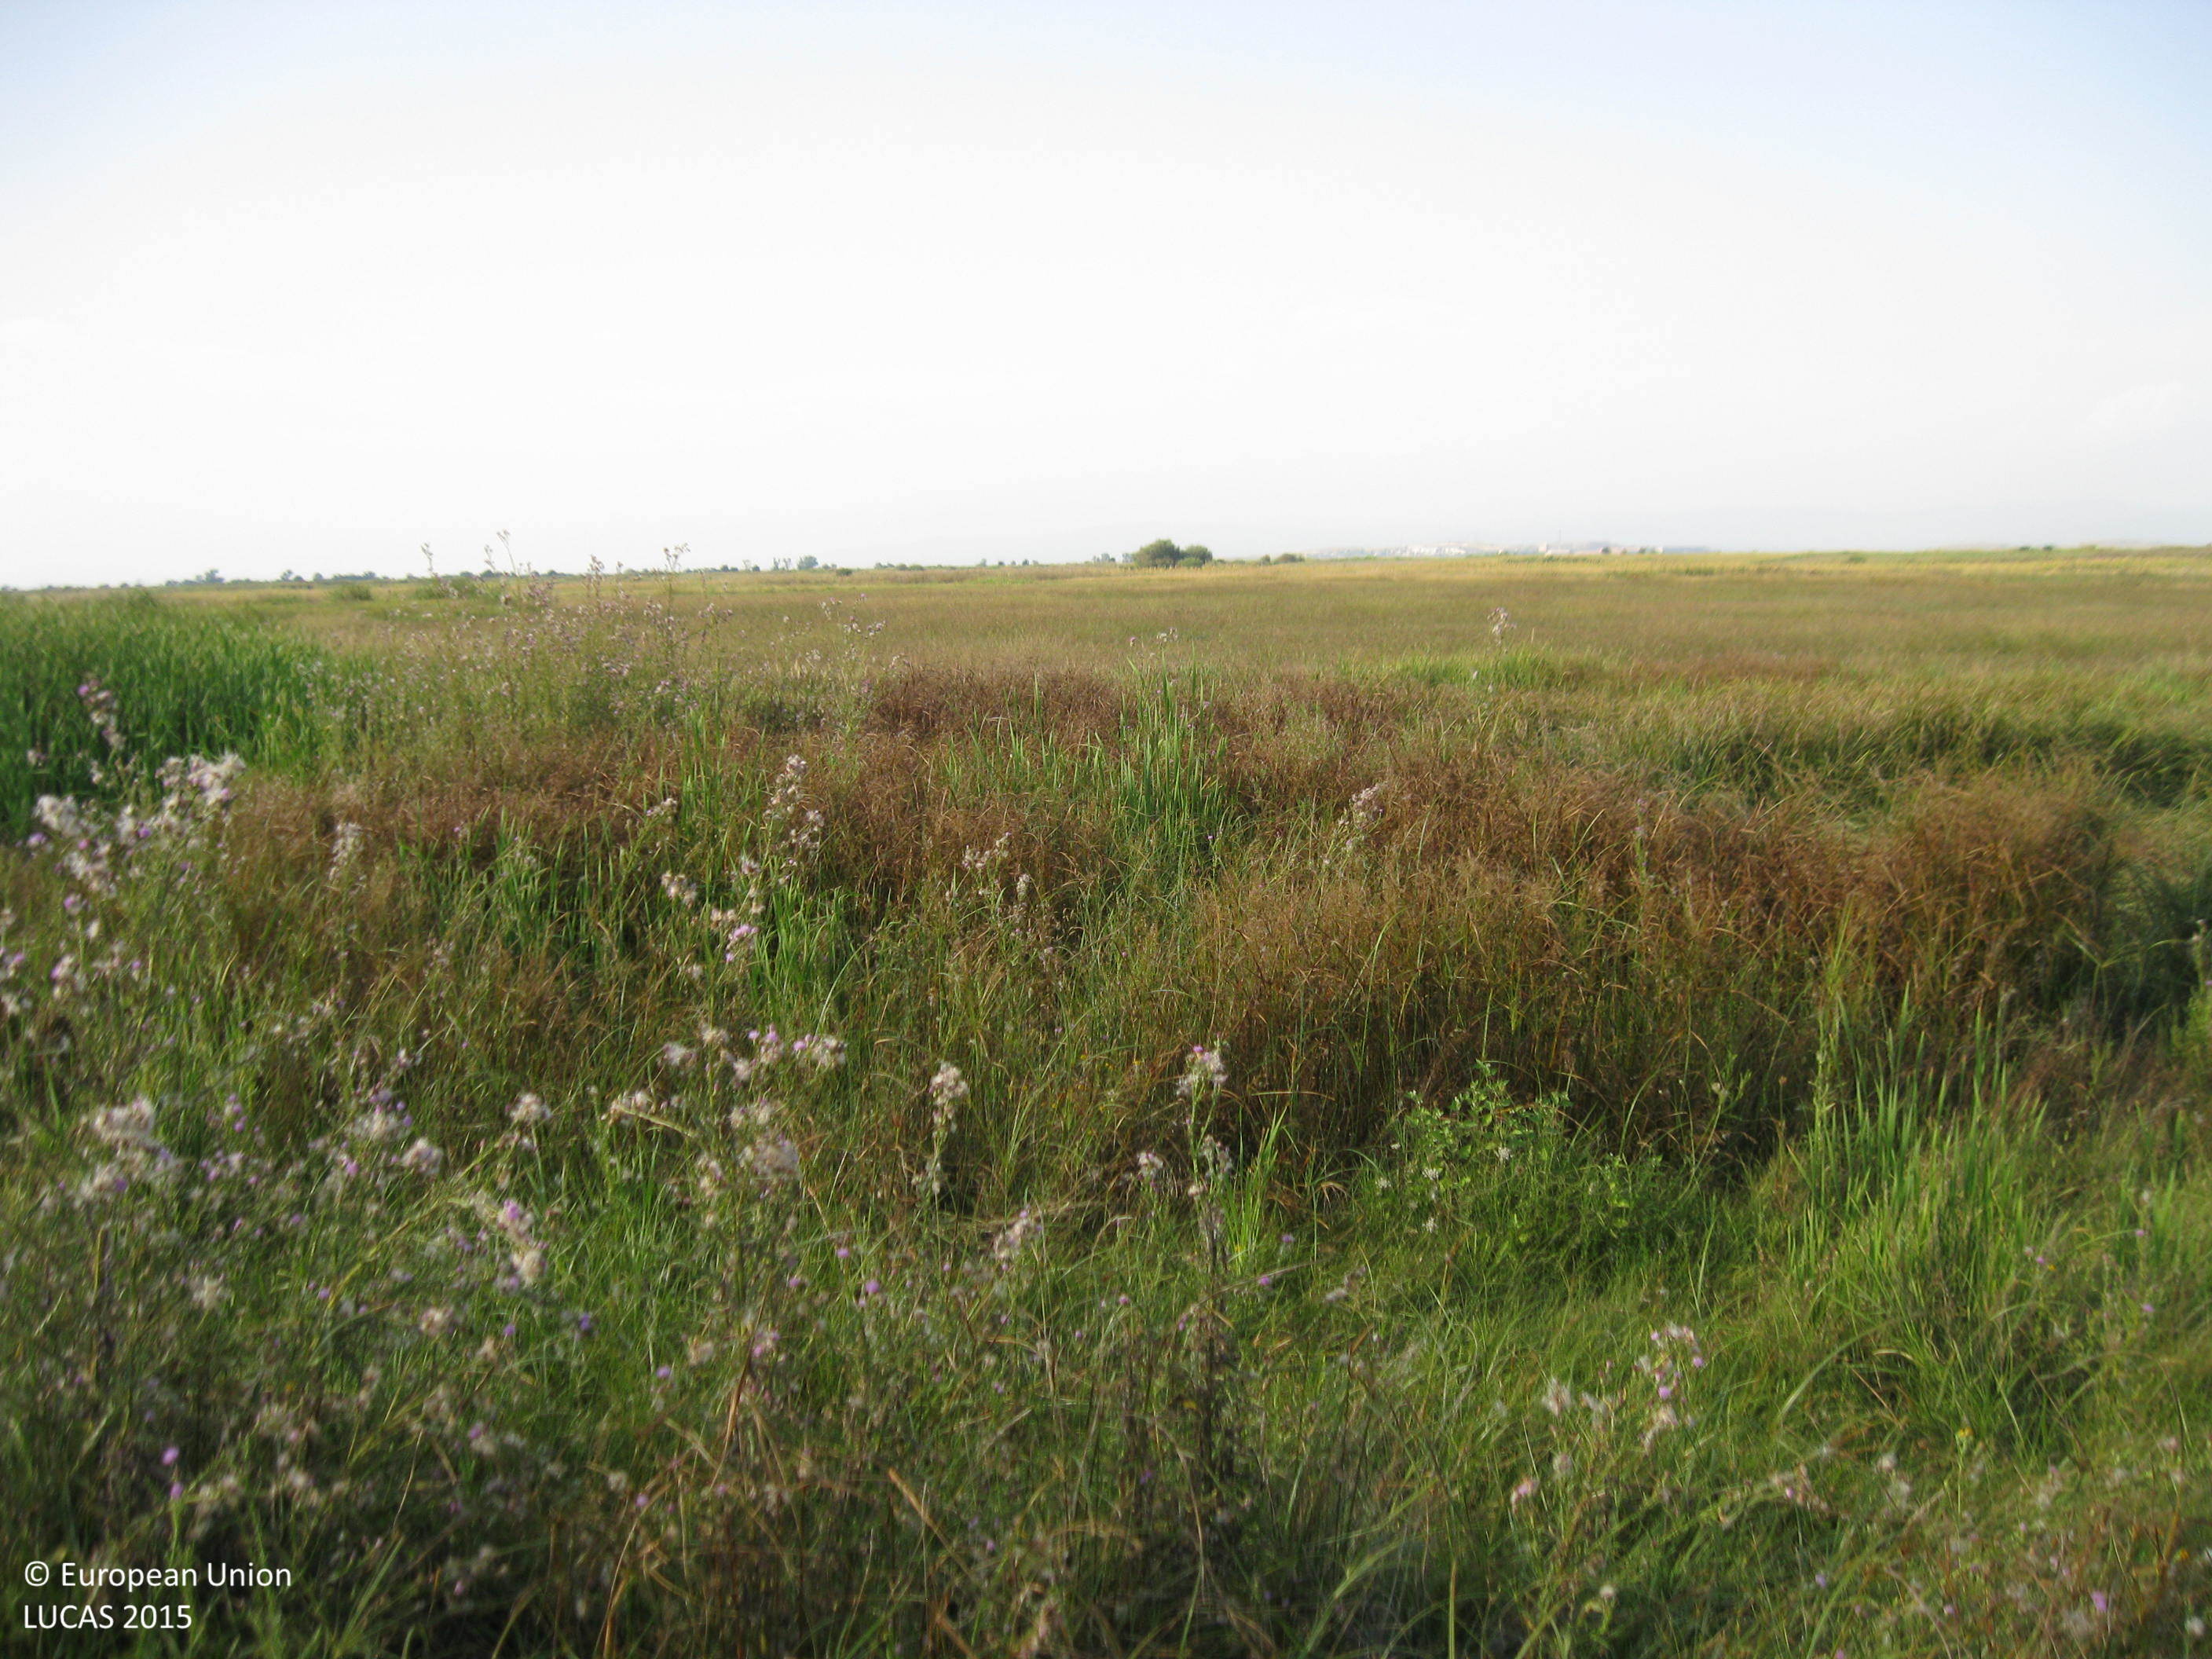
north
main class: Grassland
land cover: Grassland without tree/shrub cover
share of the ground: > 75 %
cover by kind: herbaceous plants 100 %
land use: Agriculture (excluding fallow land and kitchen gardens)
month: September
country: BG
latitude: 42.1705
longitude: 25.0064
